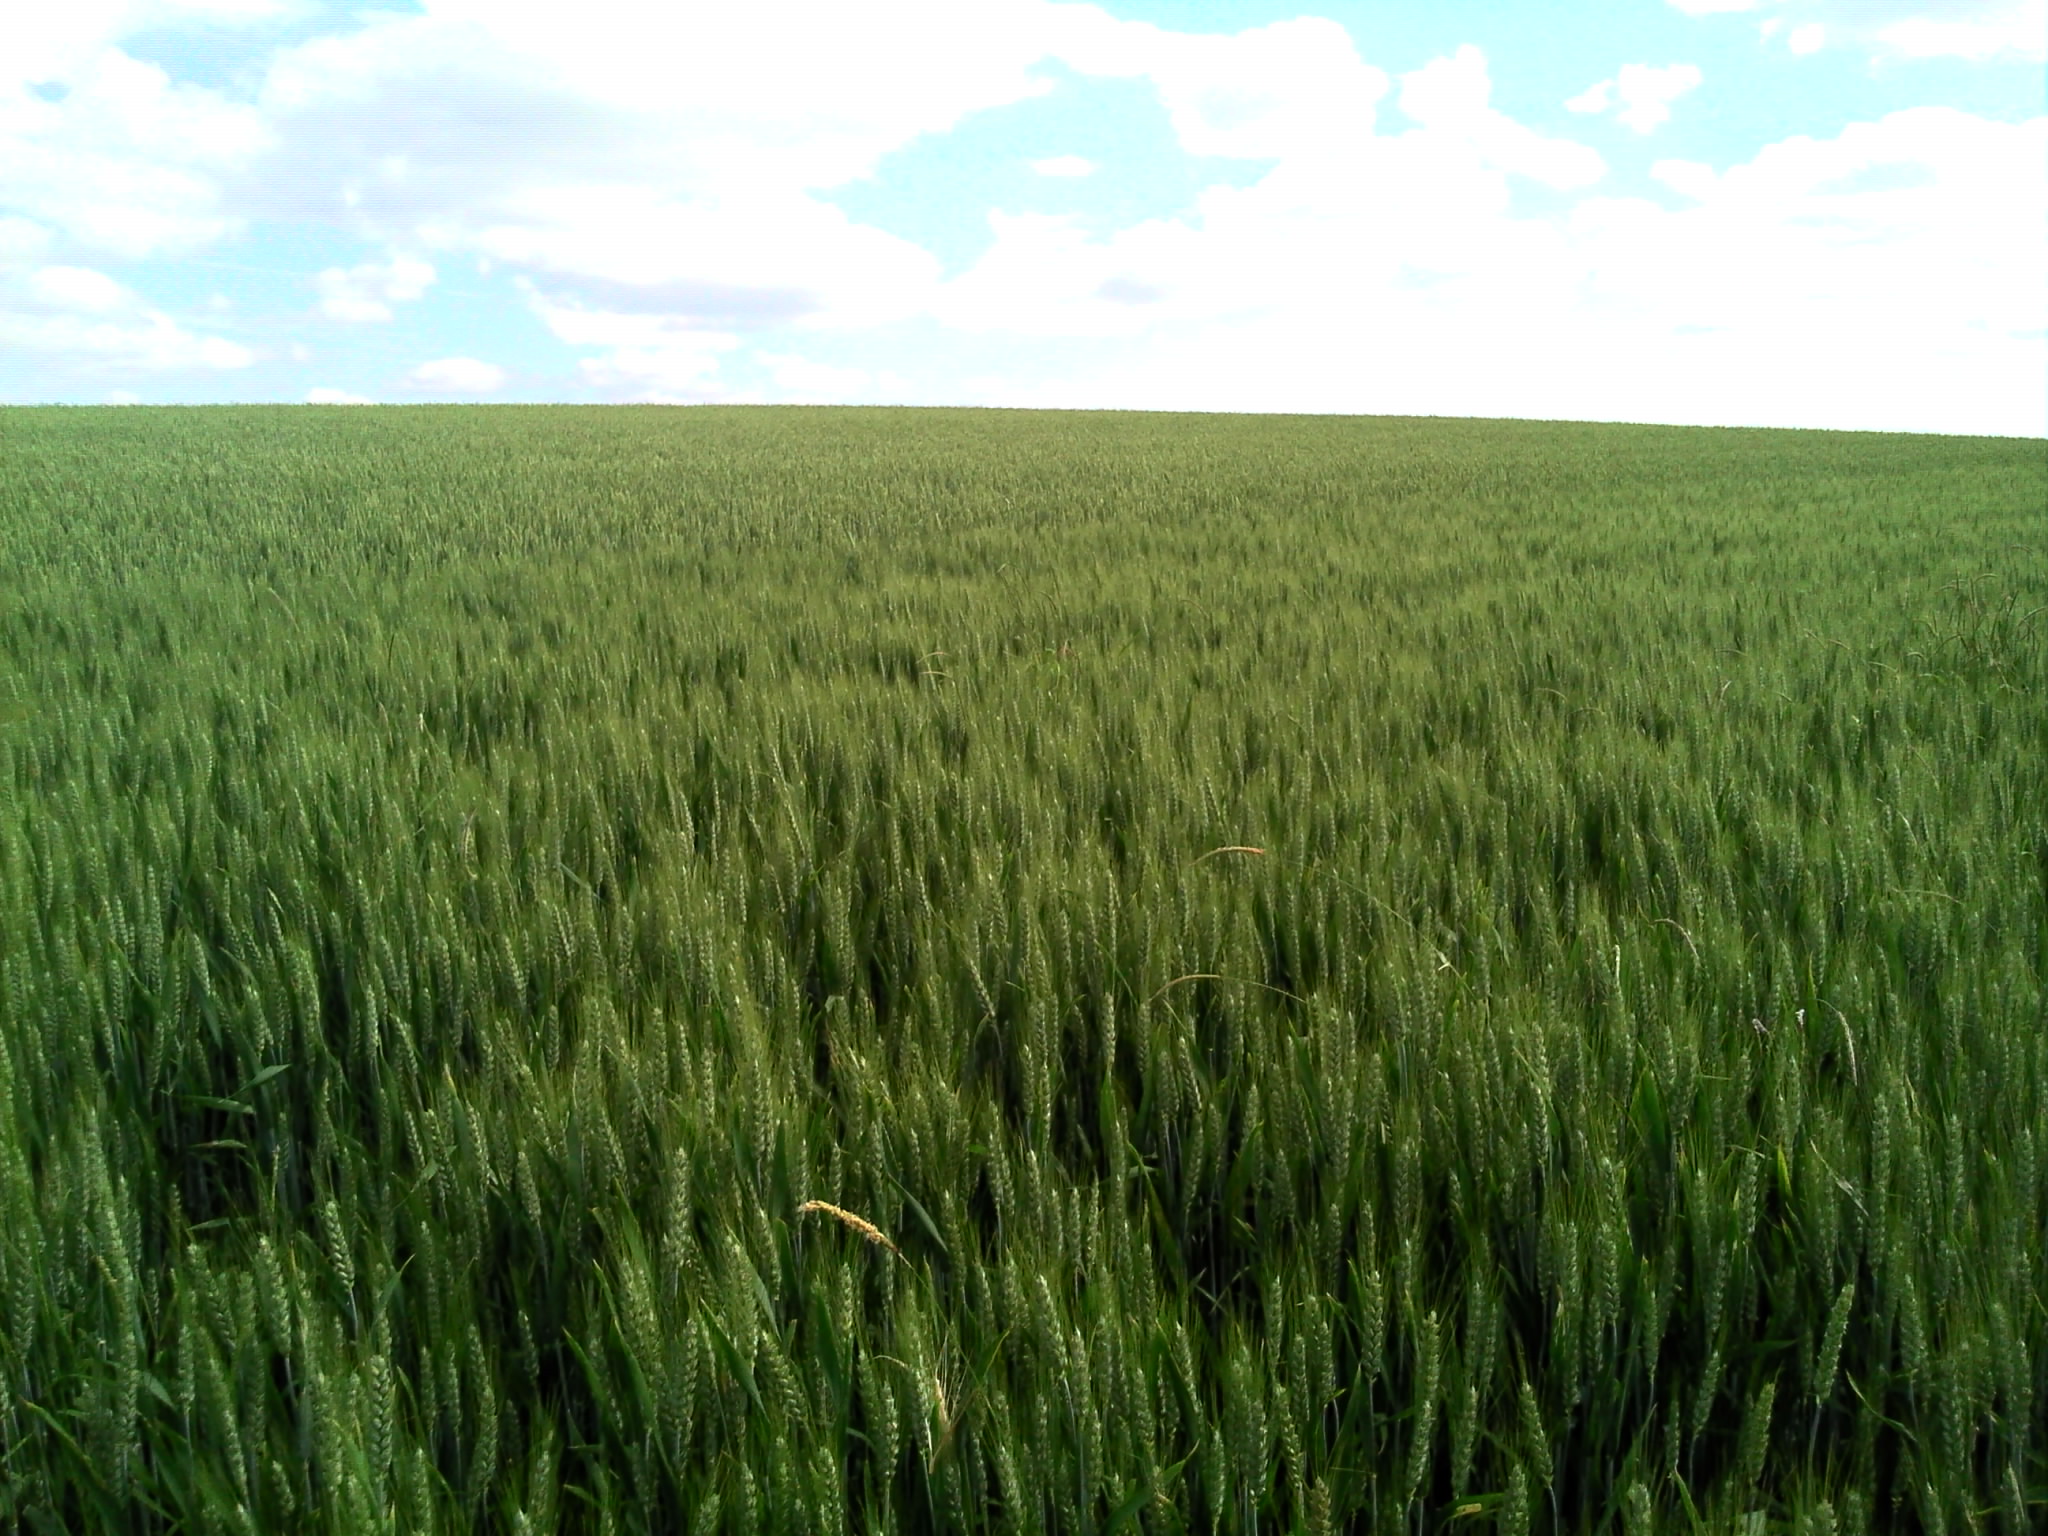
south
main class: Cropland
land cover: Common wheat
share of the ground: > 75 %
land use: Agriculture (excluding fallow land and kitchen gardens)
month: May
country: FR
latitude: 46.9140
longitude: 0.3817
